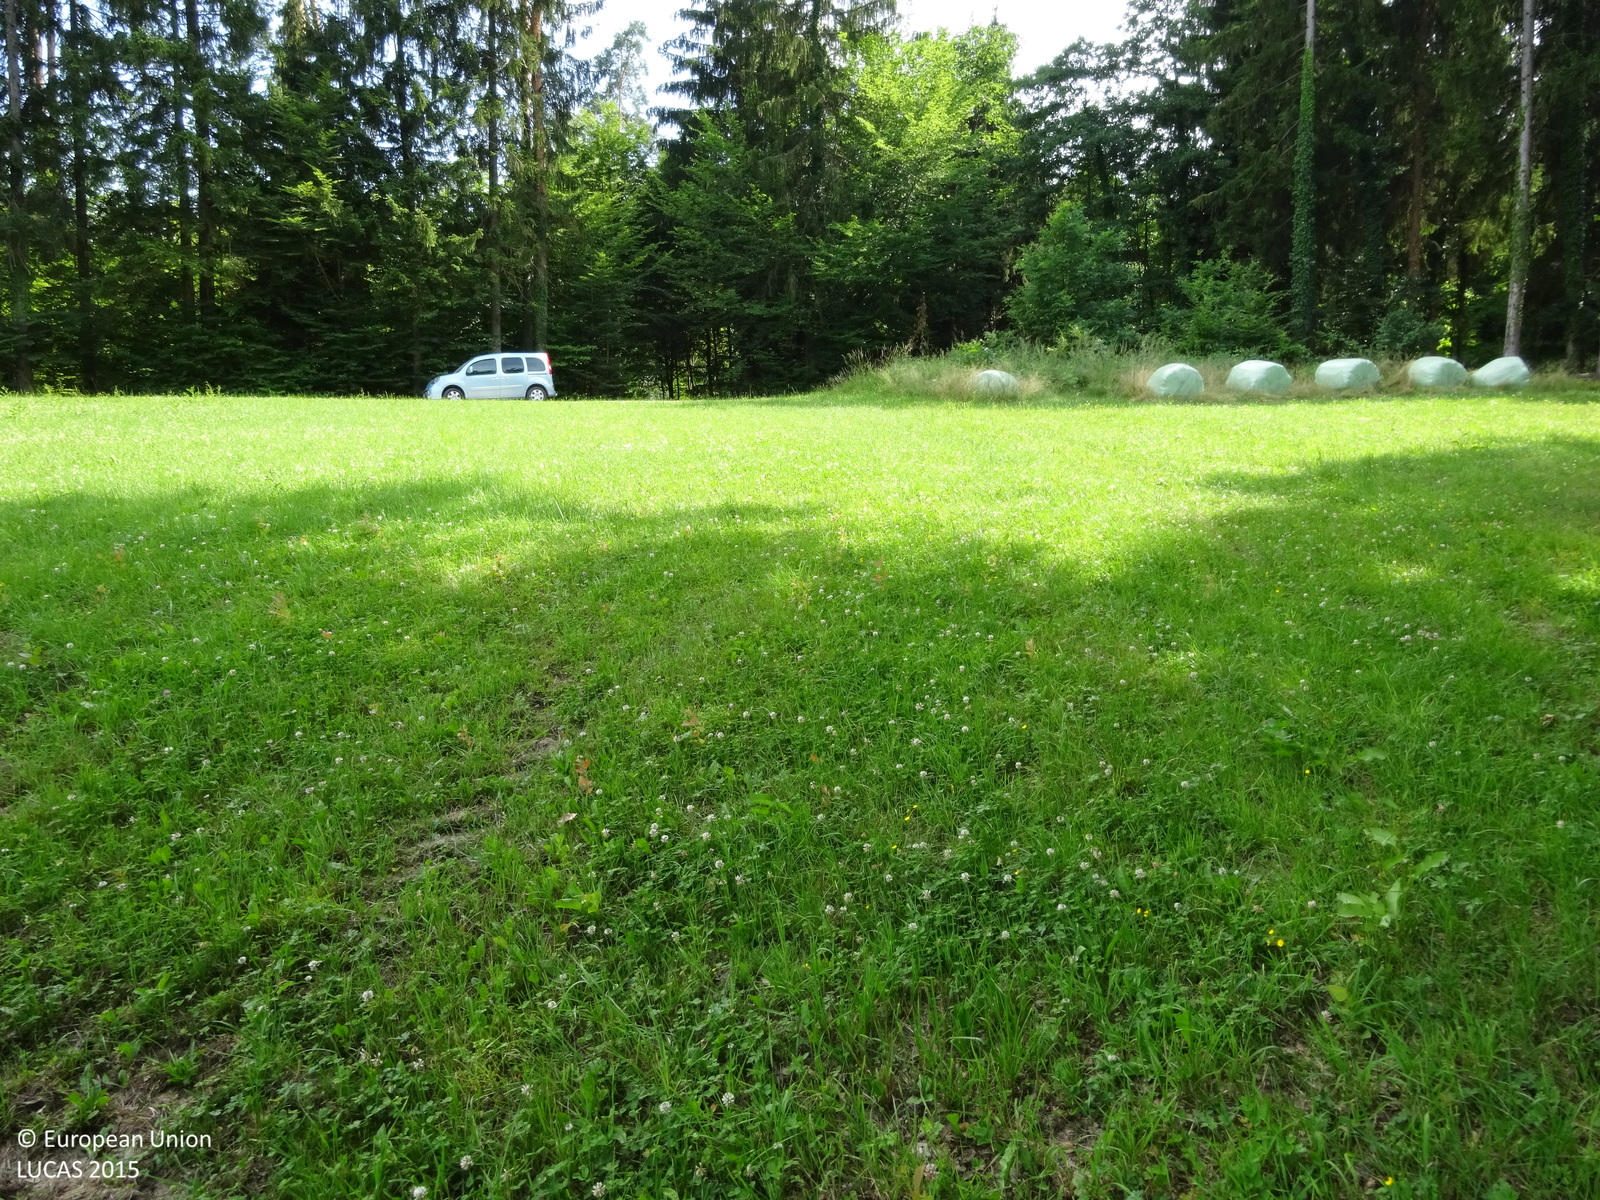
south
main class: Grassland
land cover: Grassland without tree/shrub cover
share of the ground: > 75 %
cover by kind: herbaceous plants 100 %
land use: Agriculture (excluding fallow land and kitchen gardens)
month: July
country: AT
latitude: 47.0740
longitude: 15.1749
